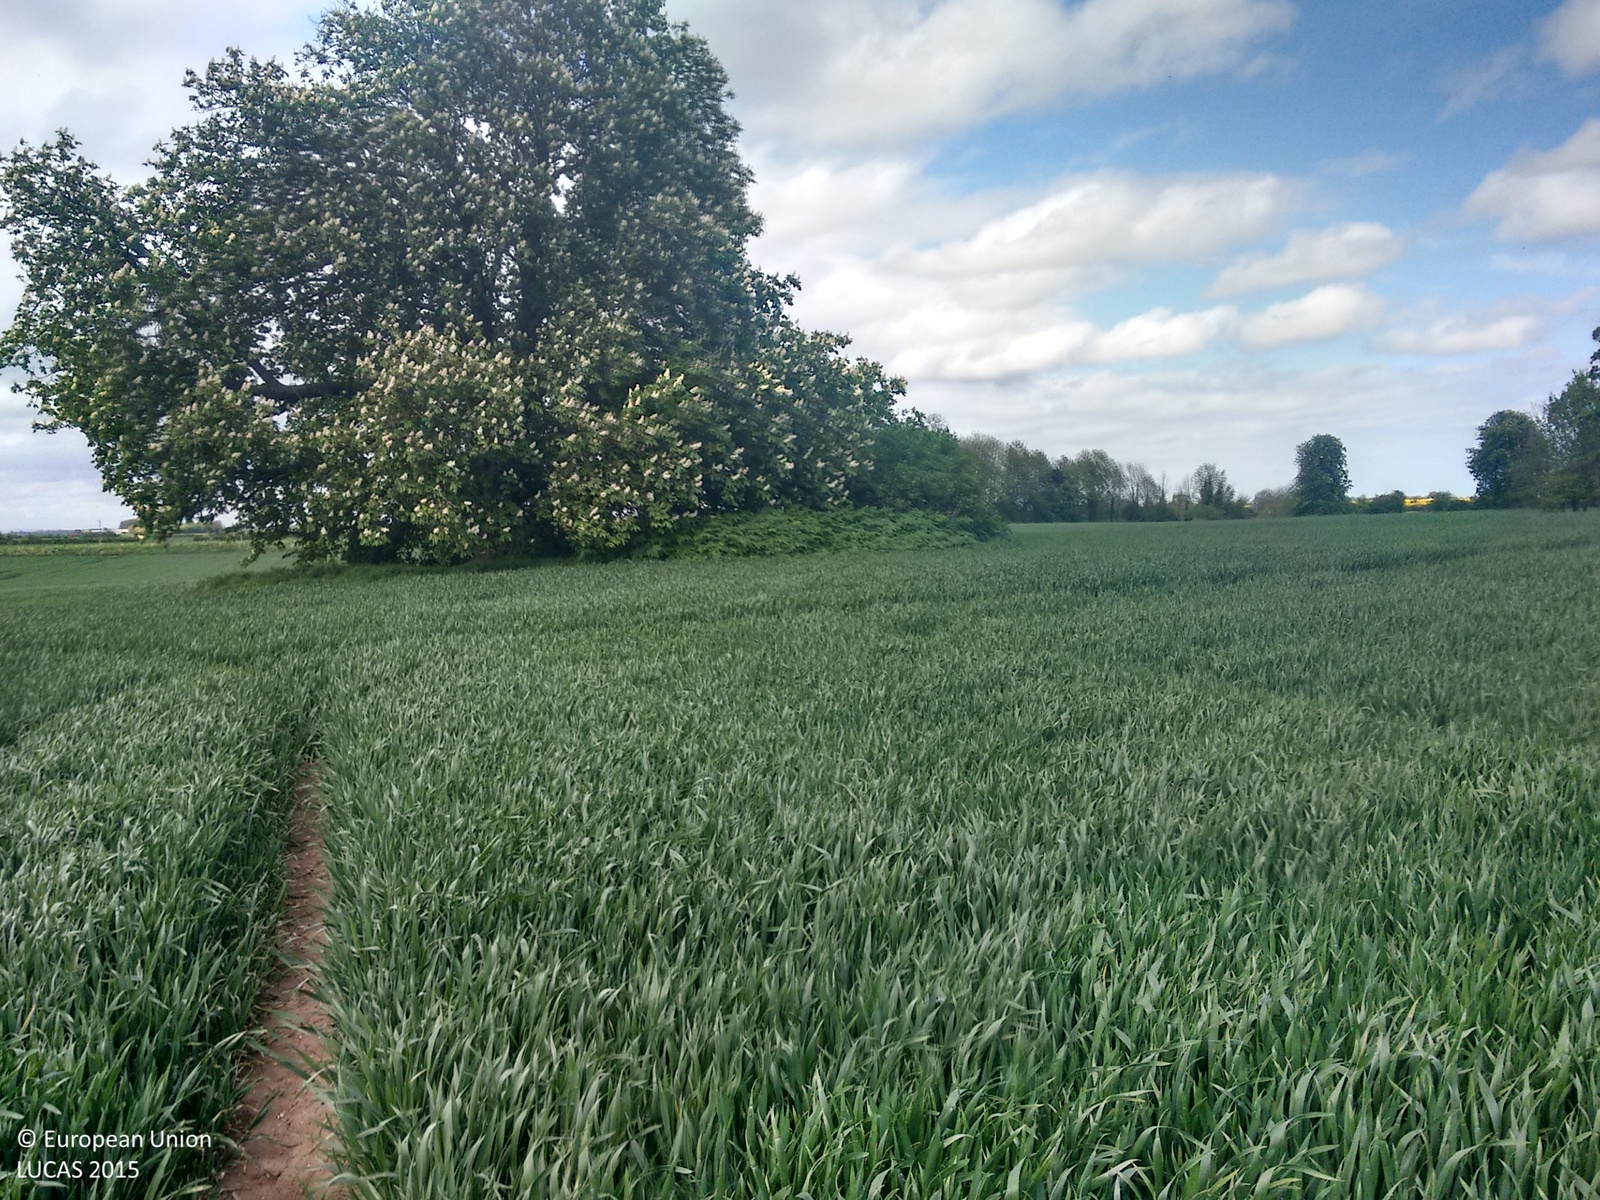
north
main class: Cropland
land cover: Common wheat
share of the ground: > 75 %
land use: Agriculture (excluding fallow land and kitchen gardens)
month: May
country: GB
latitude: 53.8326
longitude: -0.2908
